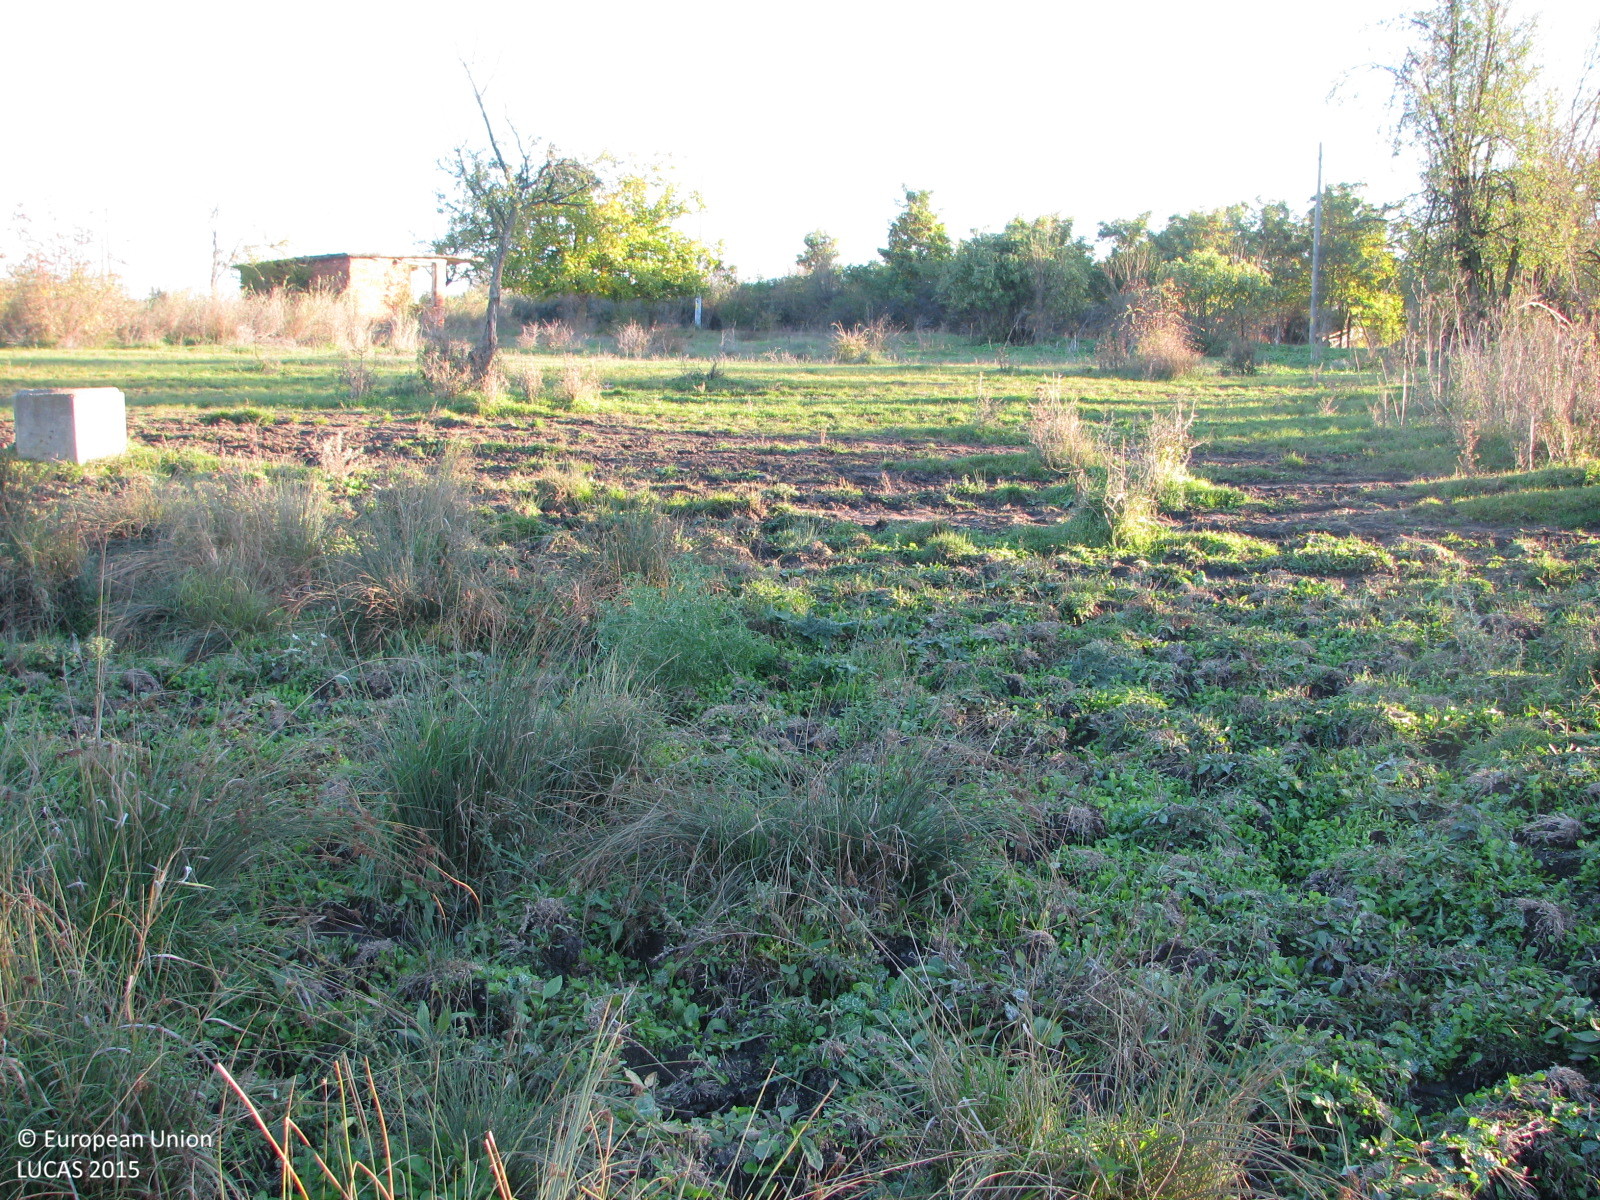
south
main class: Grassland
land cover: Spontaneously vegetated surfaces
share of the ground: > 75 %
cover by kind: herbaceous plants 95 %, consolidated bare surface 5 %
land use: Agriculture (excluding fallow land and kitchen gardens)
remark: Harvested field
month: November
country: BG
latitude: 42.1210
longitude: 26.6995
